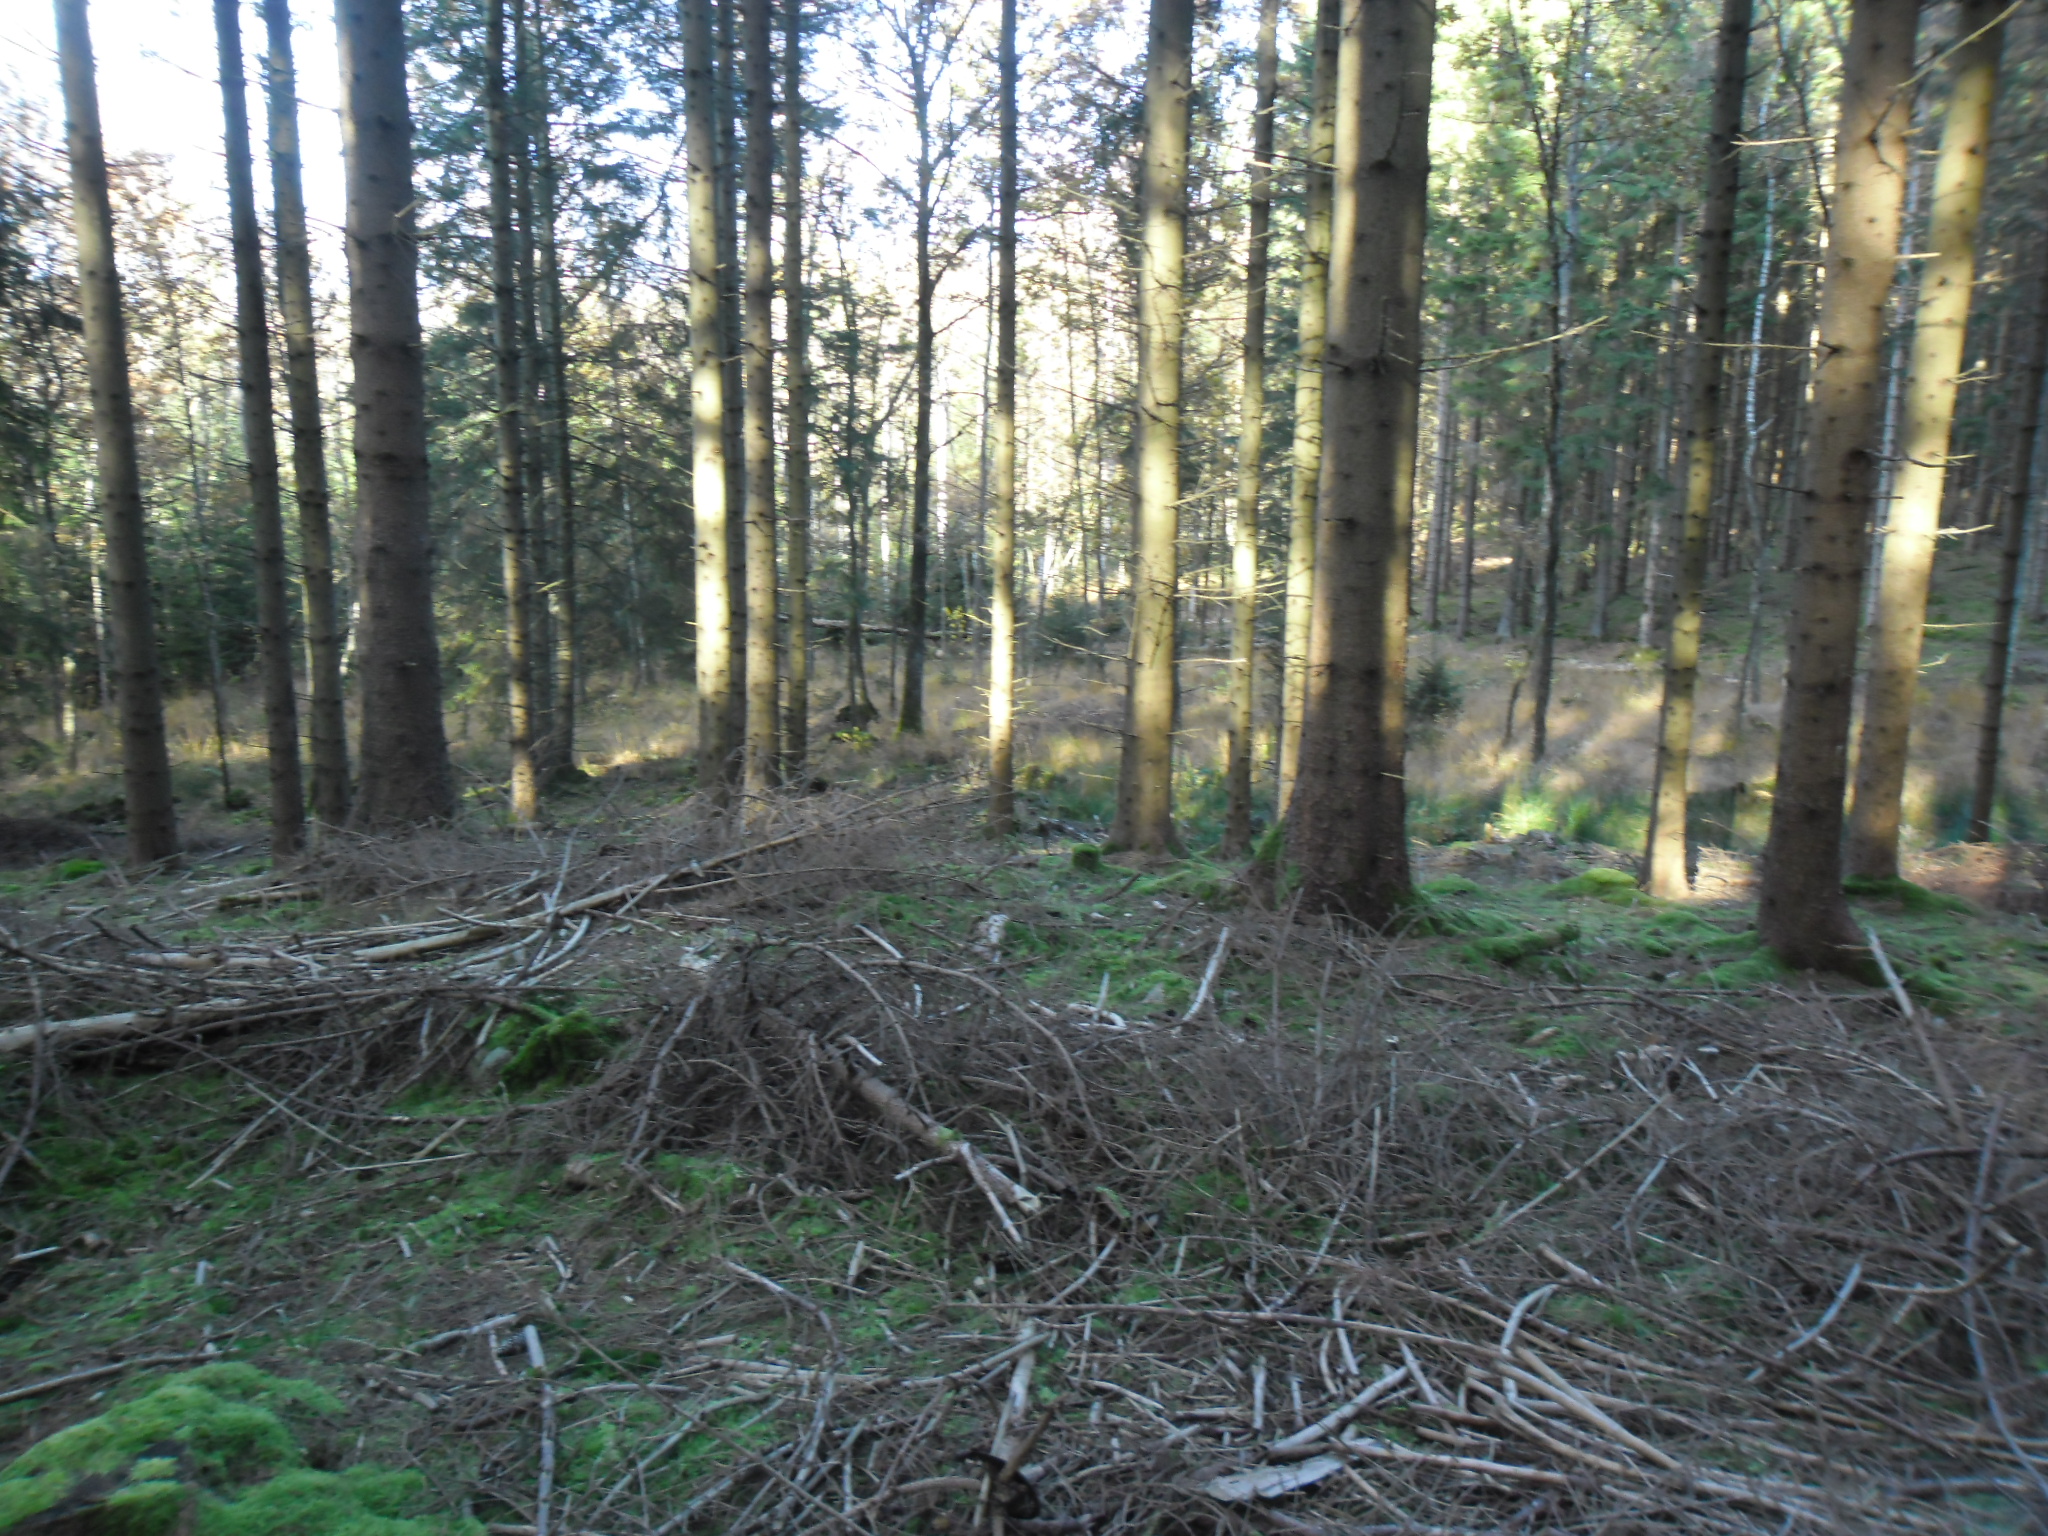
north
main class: Woodland
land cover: Spruce dominated coniferous woodland
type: boreal forest
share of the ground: > 75 %
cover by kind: coniferous forest trees 80 %, lichens and mosses 20 %
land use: Forestry
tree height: > 5 m
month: October
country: SE
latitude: 56.3829
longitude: 13.1553
